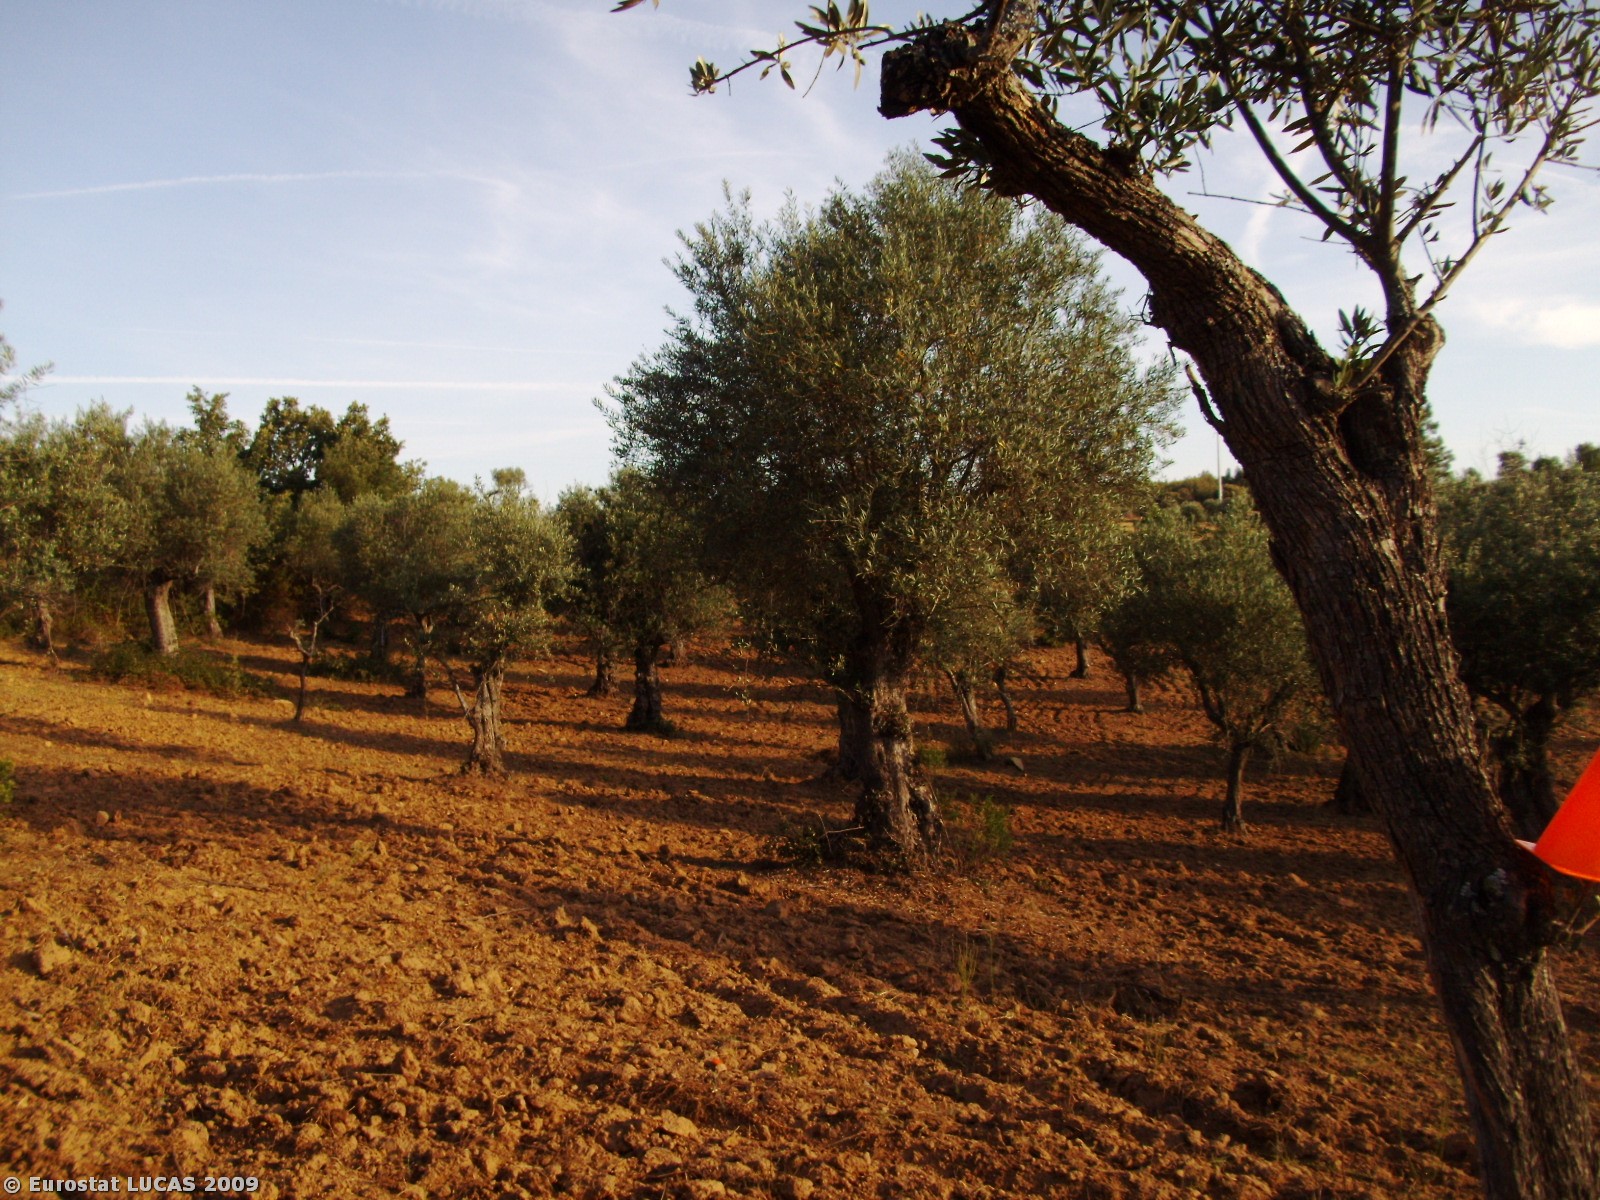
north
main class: Cropland
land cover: Olive groves
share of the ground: 50 - 75 %
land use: Agriculture (excluding fallow land and kitchen gardens)
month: June
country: PT
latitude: 40.0768
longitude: -7.2294
